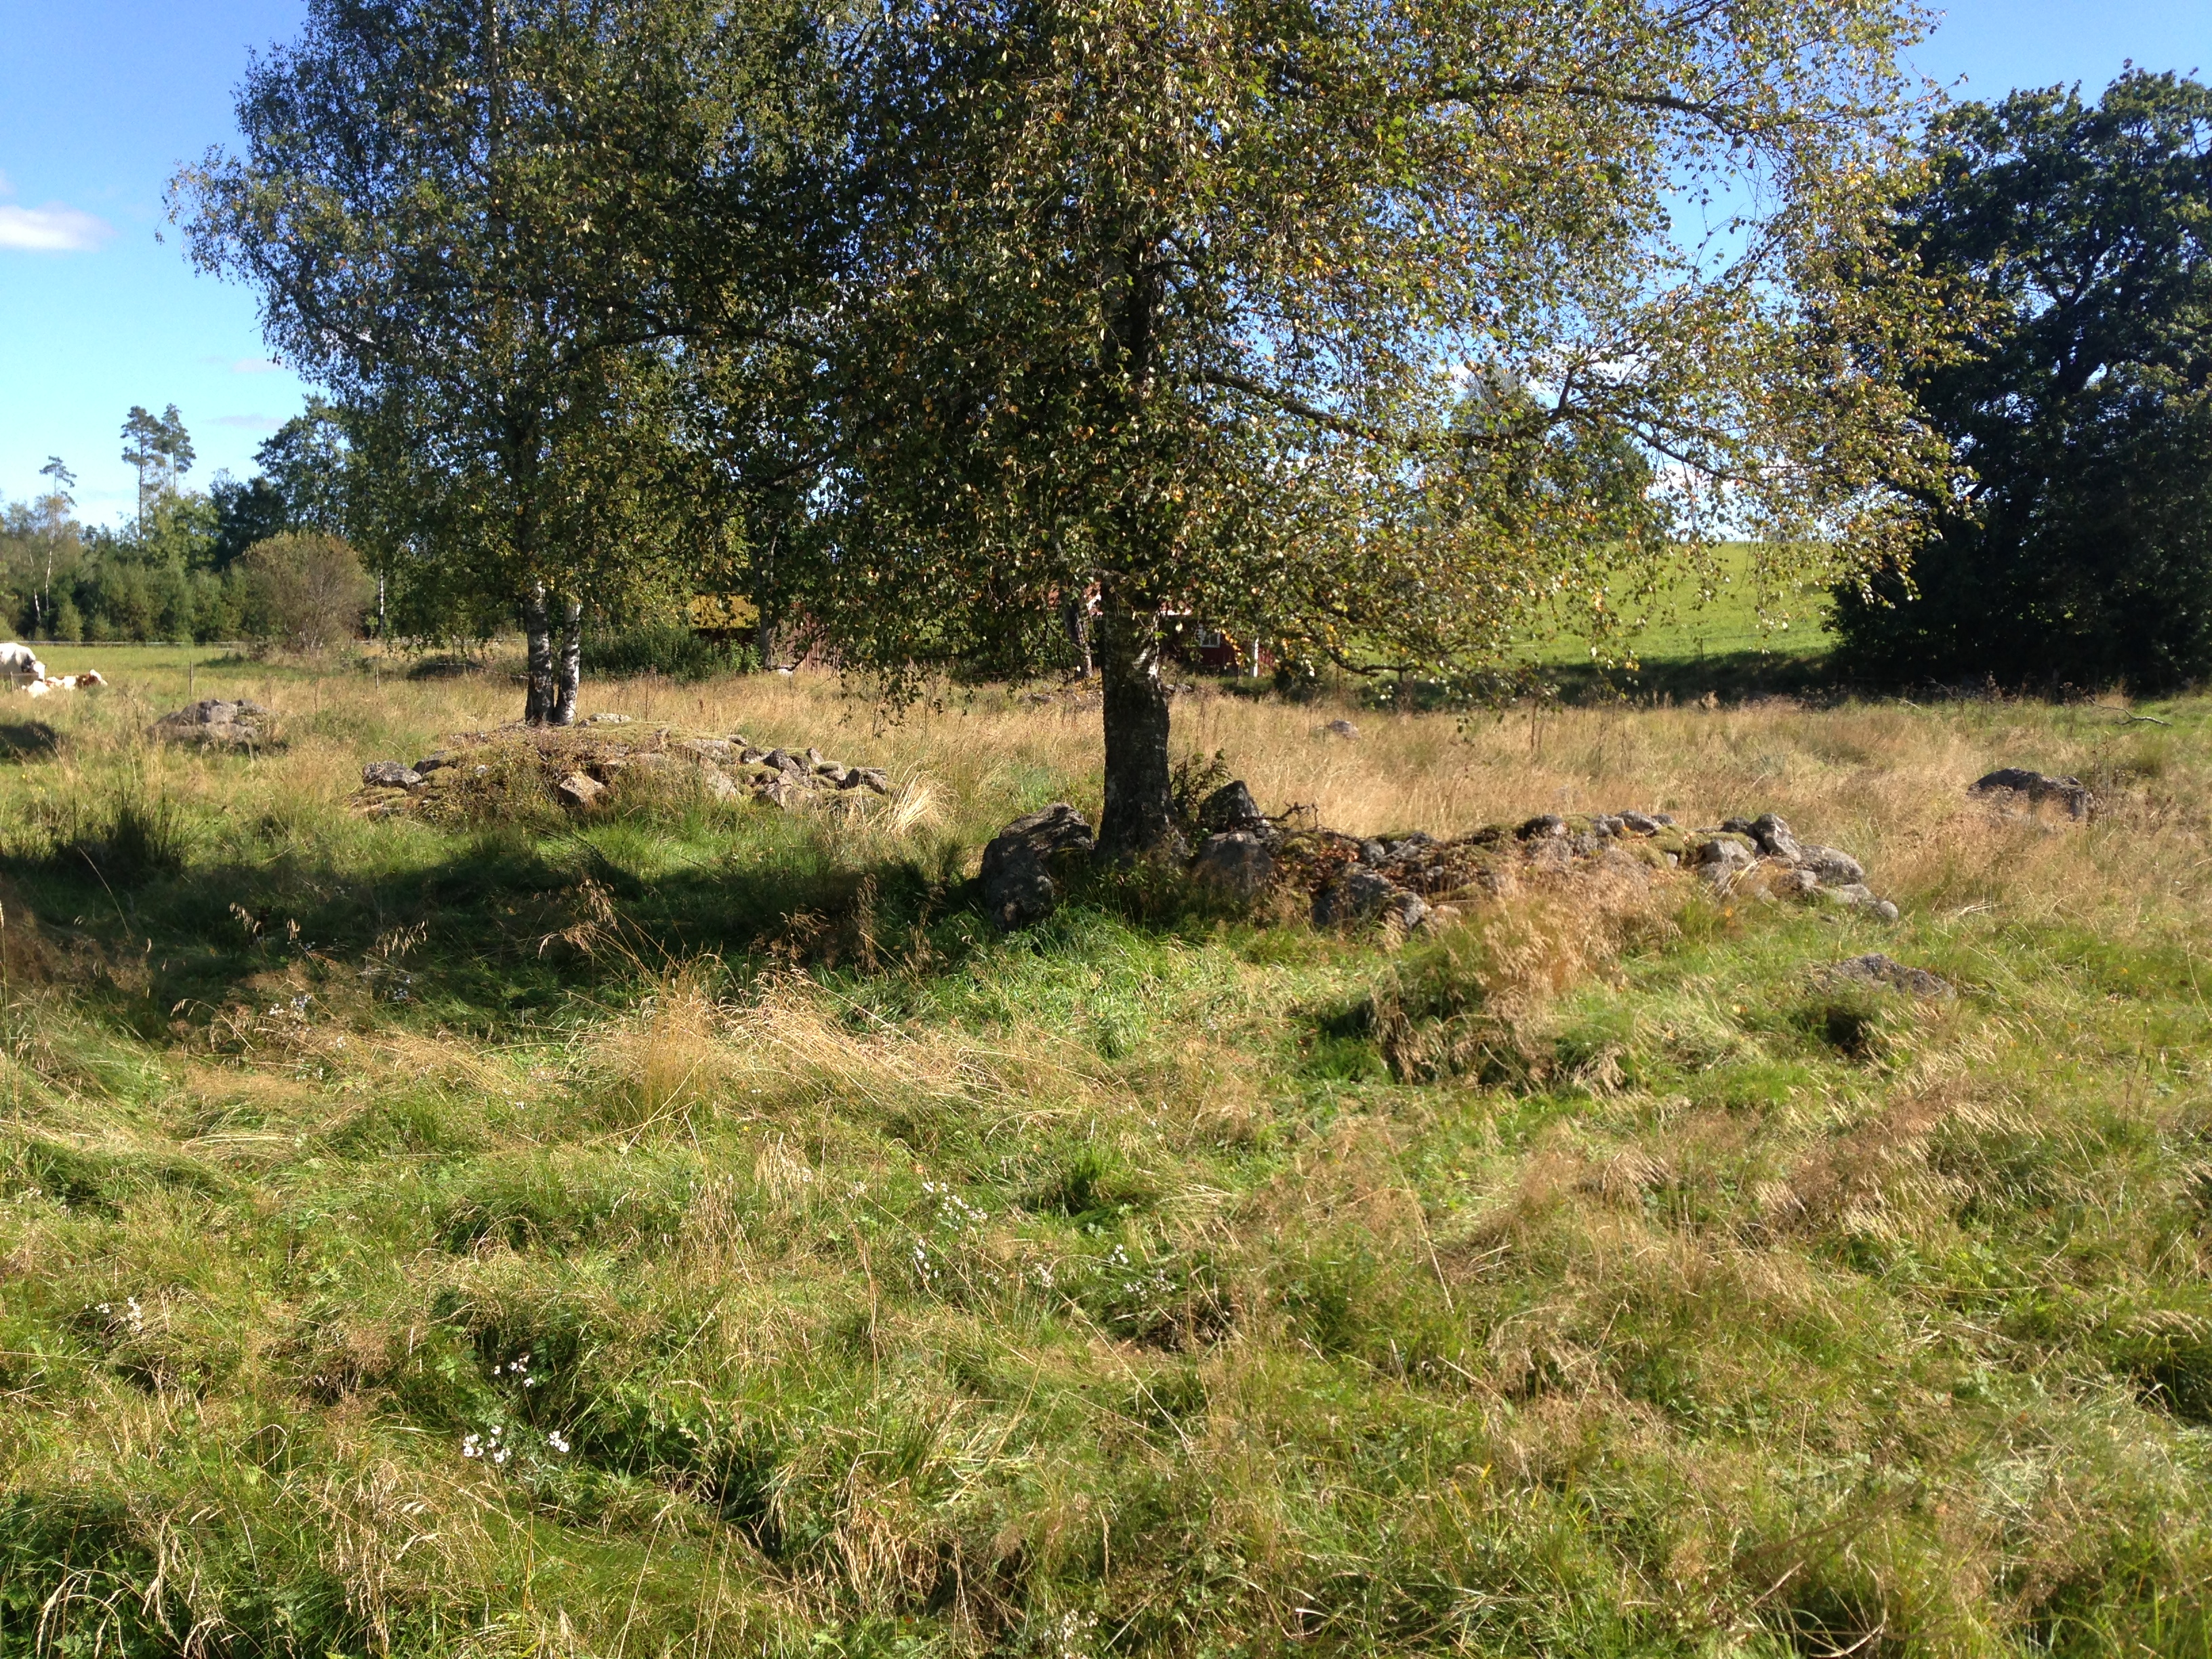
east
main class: Grassland
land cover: Grassland with sparse tree/shrub cover
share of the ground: > 75 %
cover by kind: herbaceous plants 90 %, broadleaved forest trees 5 %, shrubs 5 %
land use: Agriculture (excluding fallow land and kitchen gardens)
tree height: > 5 m
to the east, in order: Grassland with sparse tree/shrub cover; Grassland without tree/shrub cover; Fences; Grassland without tree/shrub cover; Artificial constructions in urban areas; Broadleaved woodland; Rocks and stones; Fences; Grassland without tree/shrub cover; Fences; Spontaneously vegetated surfaces; Broadleaved woodland; Grassland with sparse tree/shrub cover; Broadleaved woodland
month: September
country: SE
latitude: 57.1551
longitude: 13.2198
